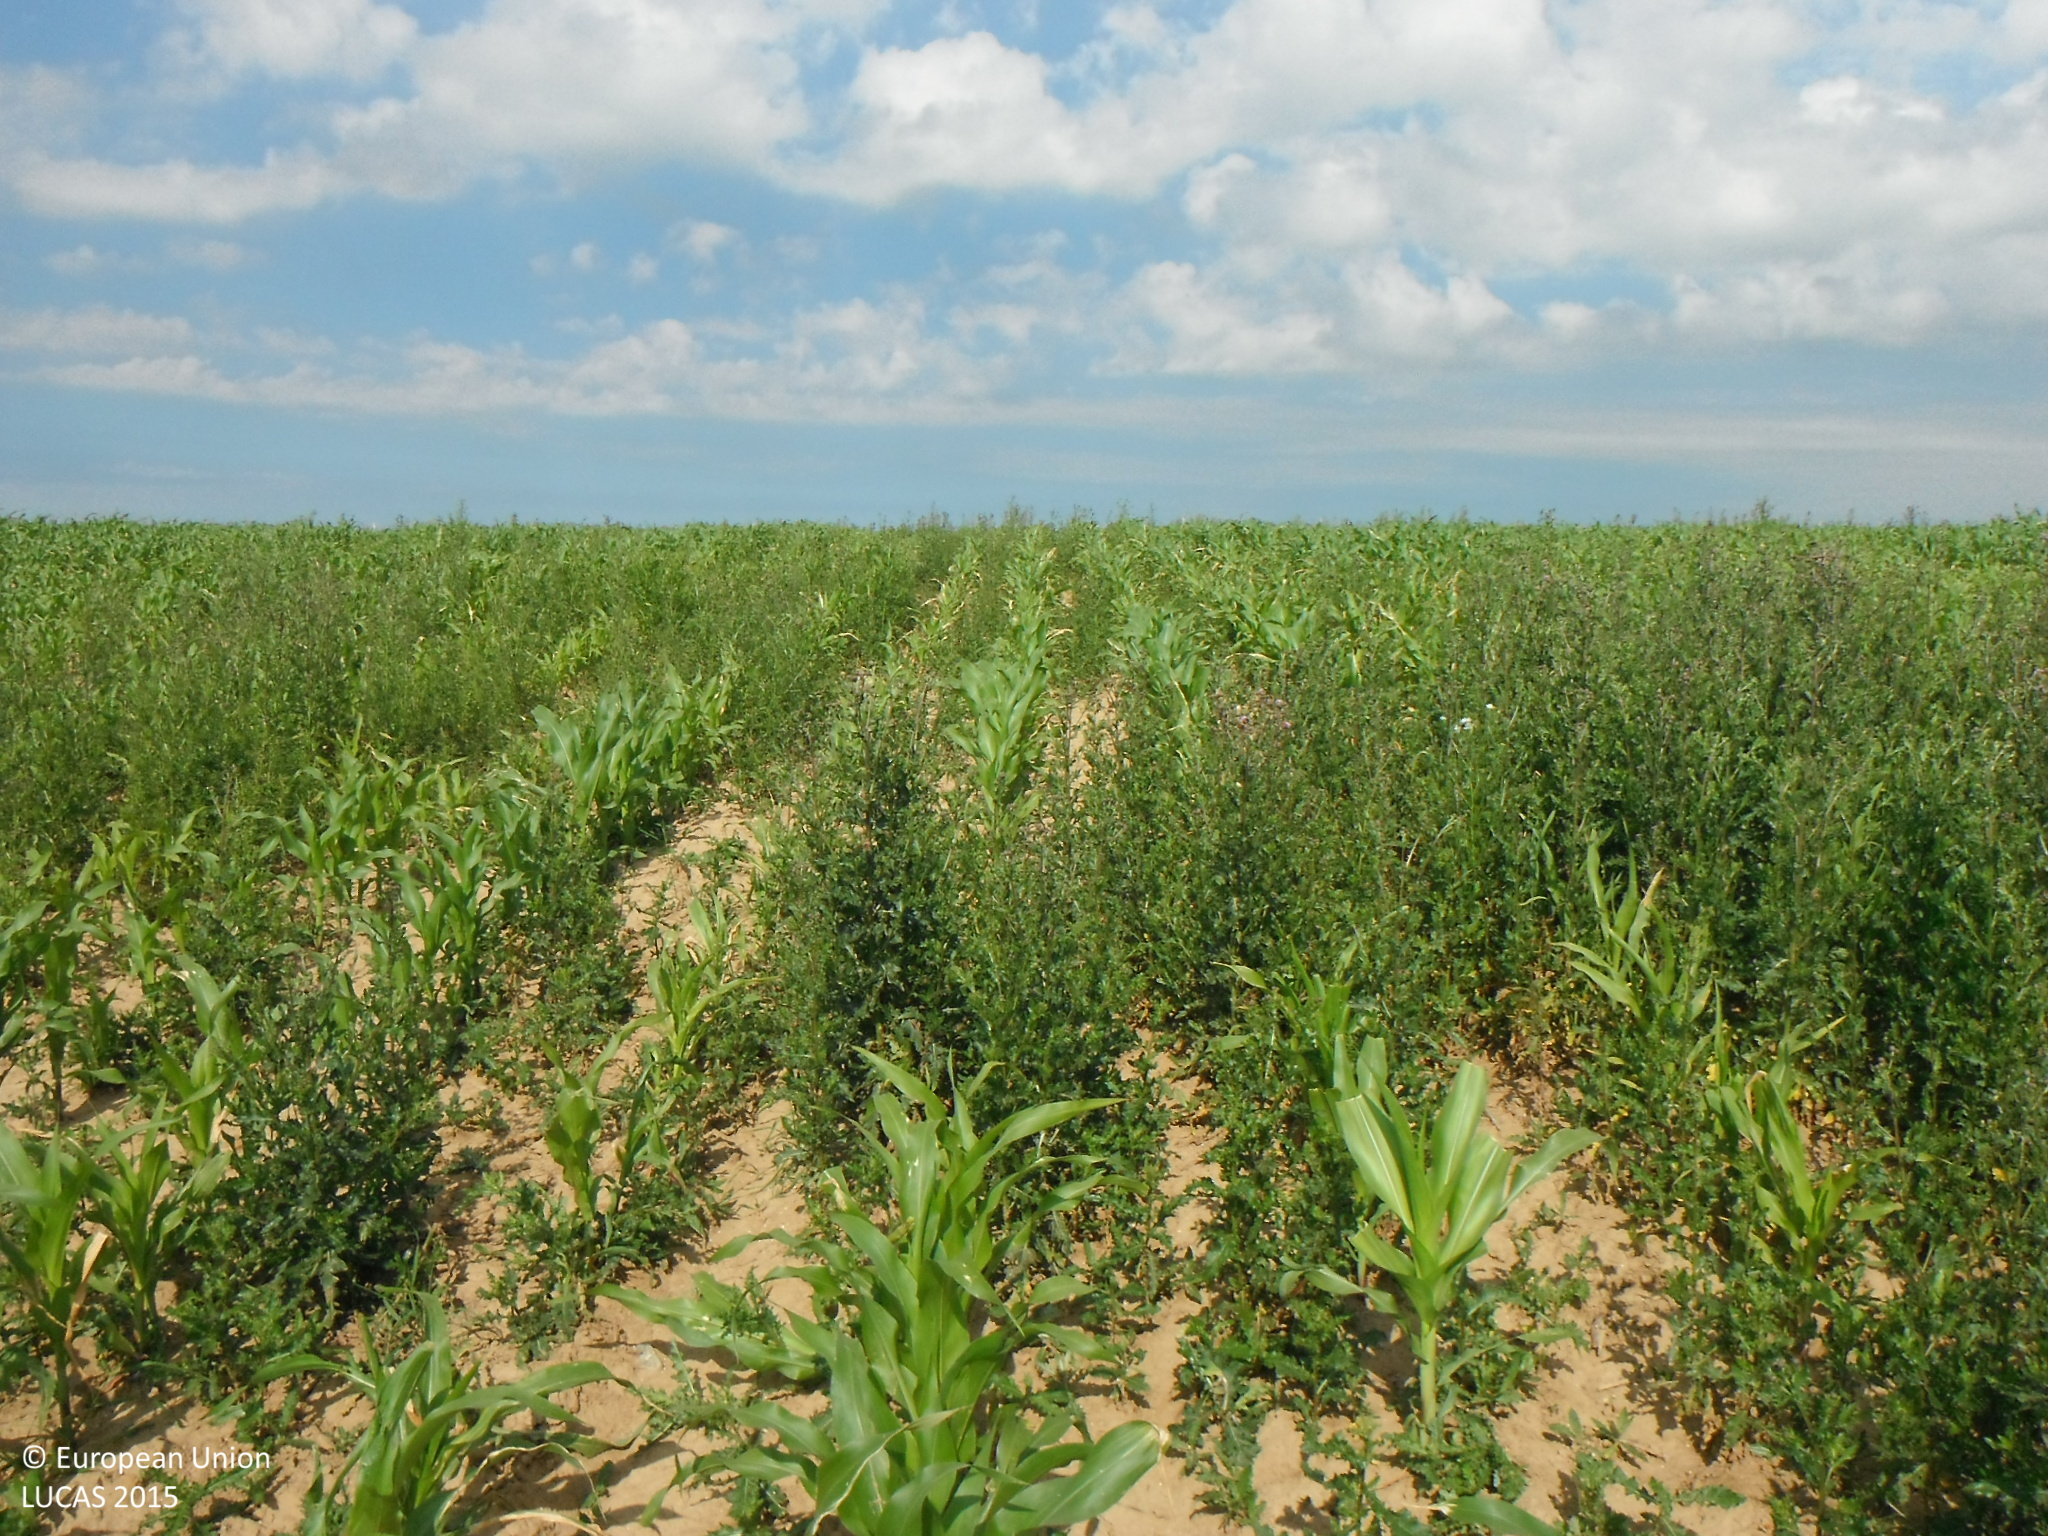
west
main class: Cropland
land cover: Maize
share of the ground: 50 - 75 %
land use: Agriculture (excluding fallow land and kitchen gardens)
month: July
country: SK
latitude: 49.1032
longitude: 19.6567
